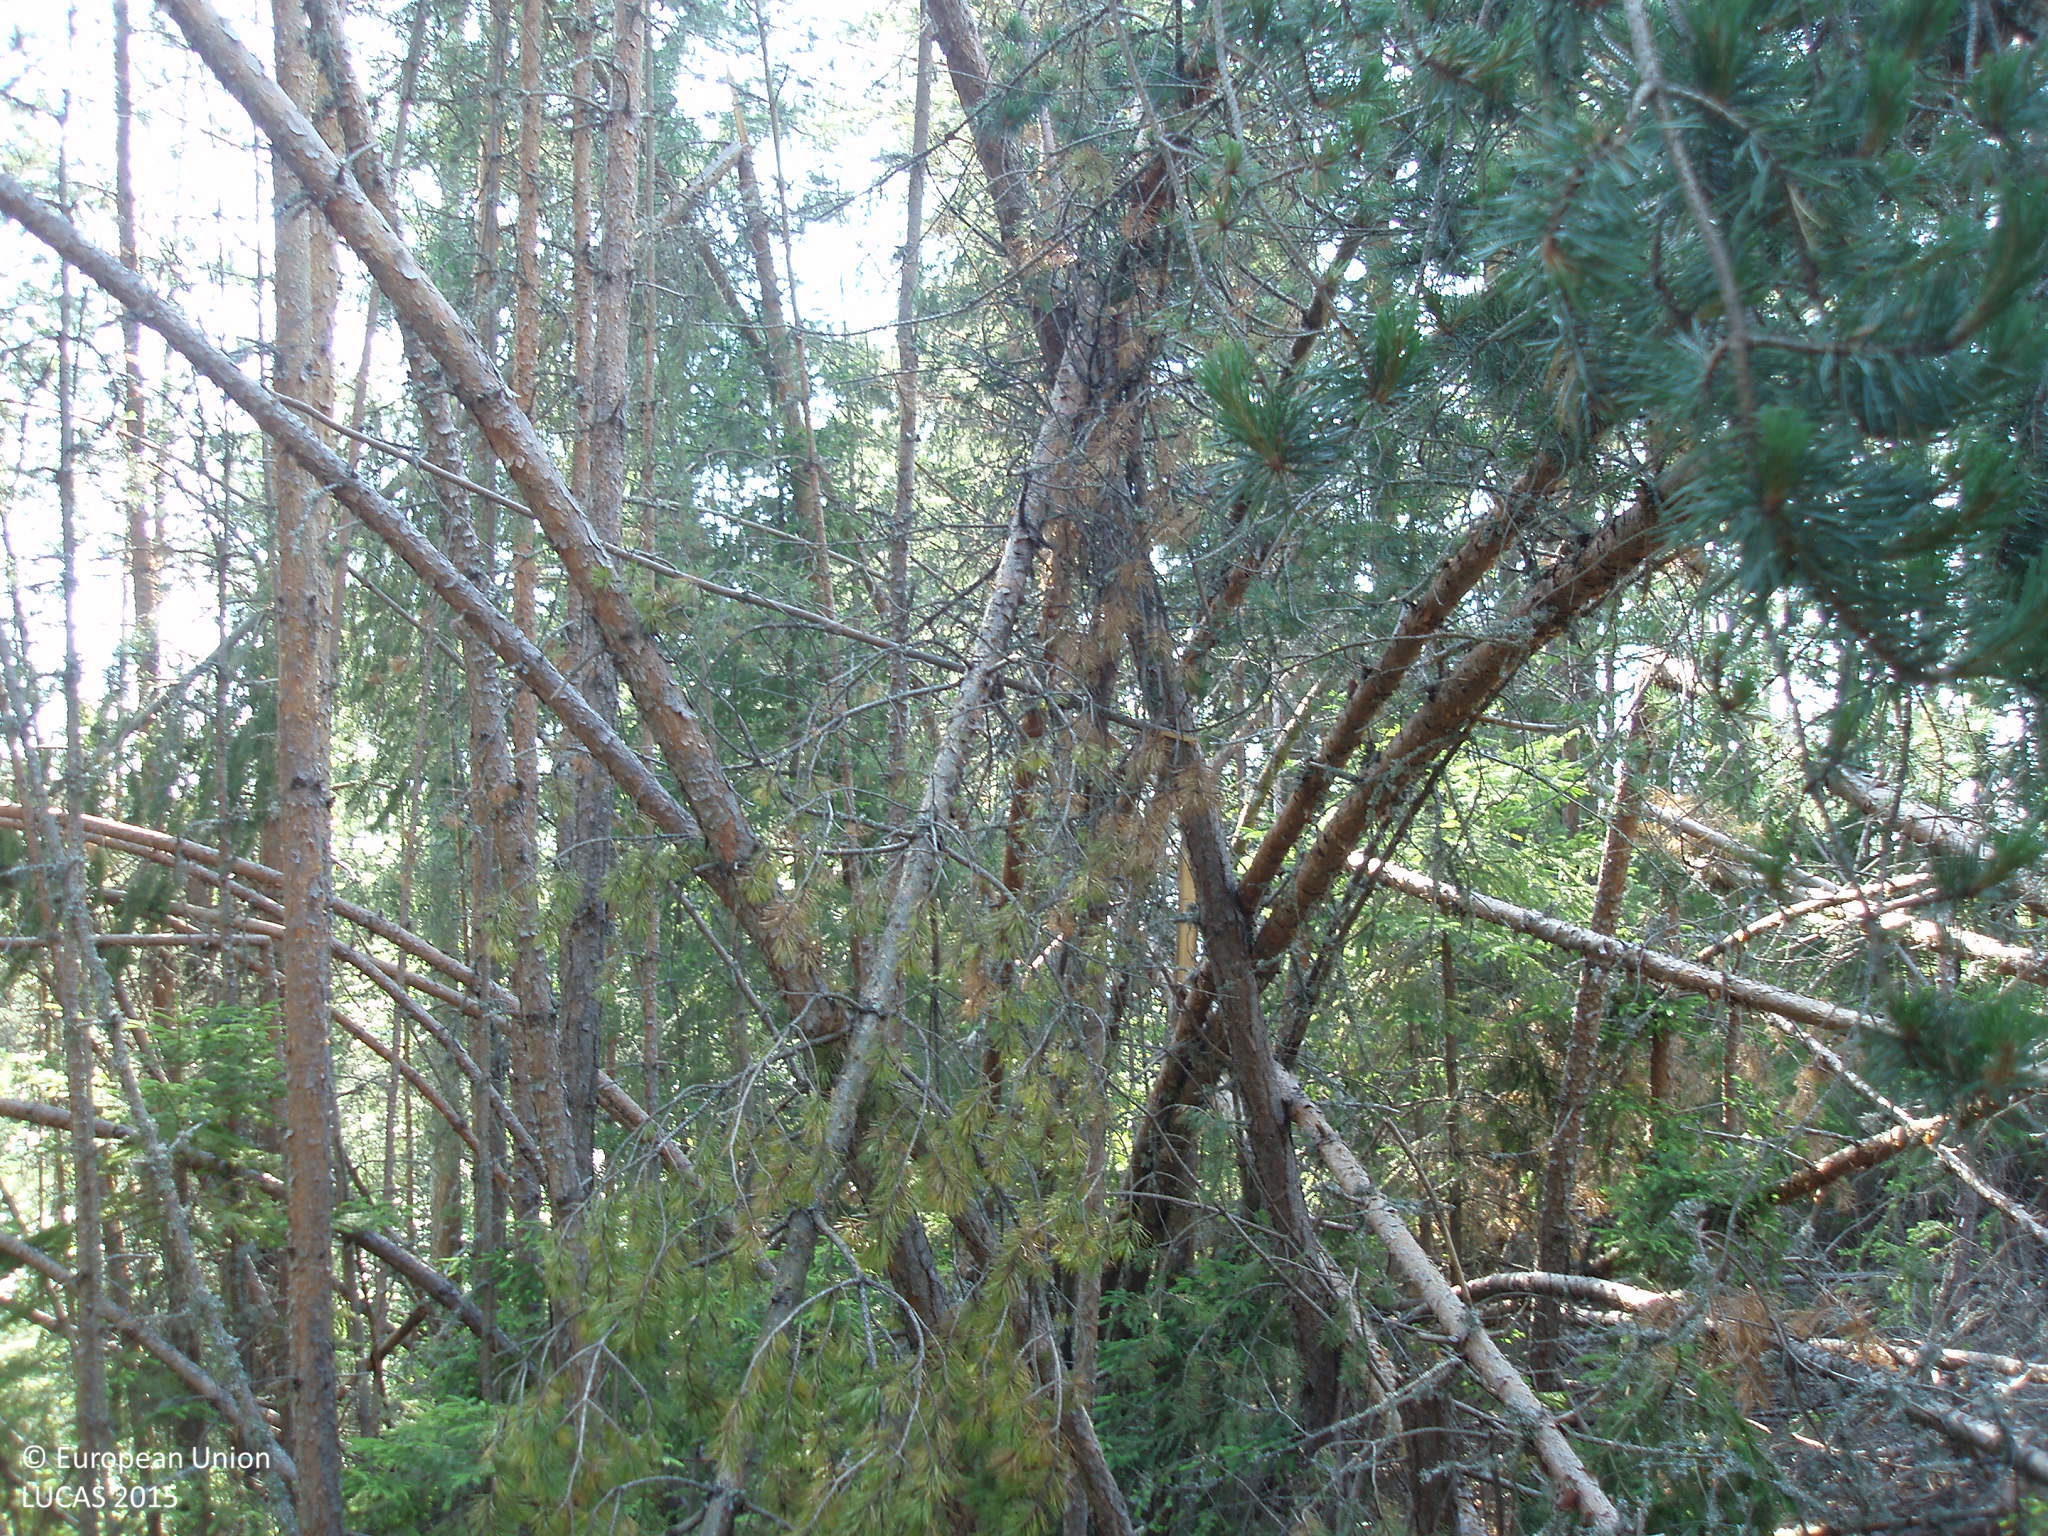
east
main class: Woodland
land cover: Pine dominated coniferous woodland
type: hemiboreal forest and nemoral coniferous forest and mixed broadleaved-coniferous forest
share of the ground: > 75 %
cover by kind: coniferous forest trees 100 %
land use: Forestry
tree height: > 5 m
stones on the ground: < 10 %
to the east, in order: Pine dominated coniferous woodland; Grassland without tree/shrub cover; Tracks; Grassland without tree/shrub cover; Pine dominated coniferous woodland; Grassland with sparse tree/shrub cover; Electric lines; Grassland with sparse tree/shrub cover
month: July
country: BG
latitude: 41.9749
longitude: 23.8280
